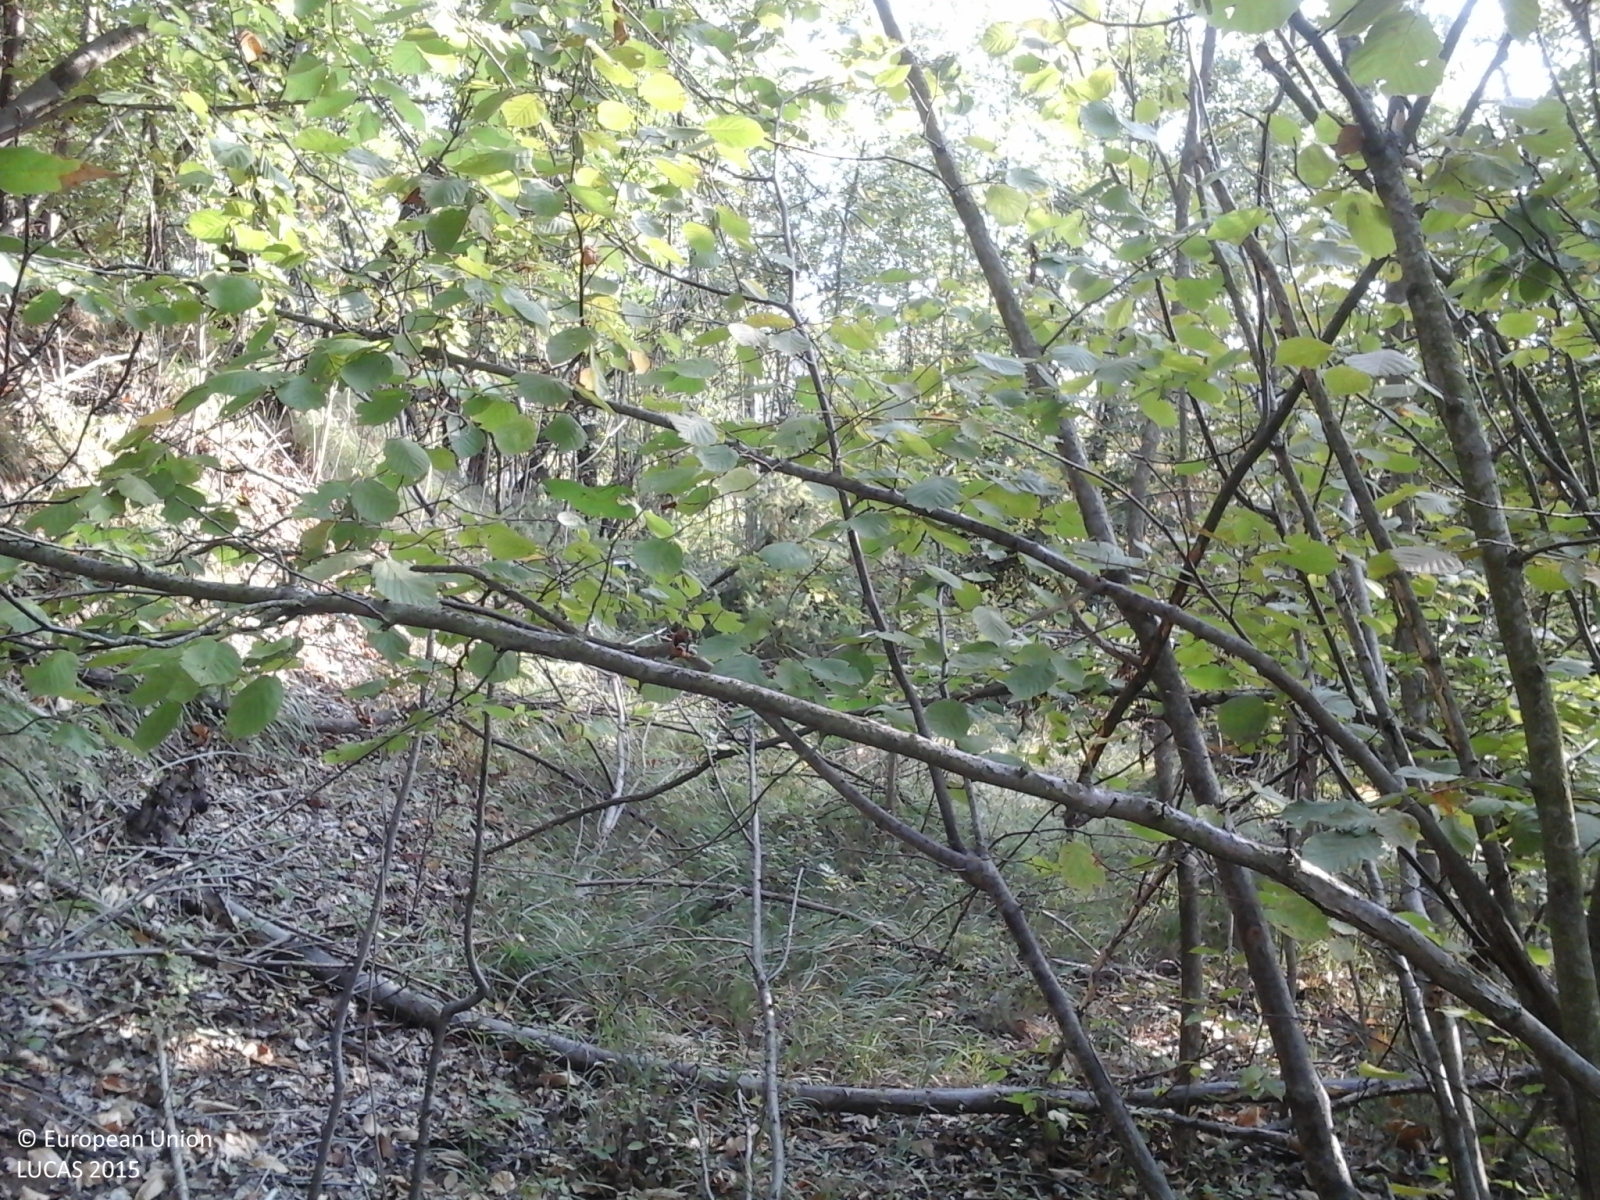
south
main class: Woodland
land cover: Broadleaved woodland
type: thermophilous deciduous forest
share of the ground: > 75 %
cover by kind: broadleaved forest trees 90 %, herbaceous plants 10 %
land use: Forestry
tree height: > 5 m
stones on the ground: 10 - 25 %
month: September
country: IT
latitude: 44.3360
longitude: 8.2606
